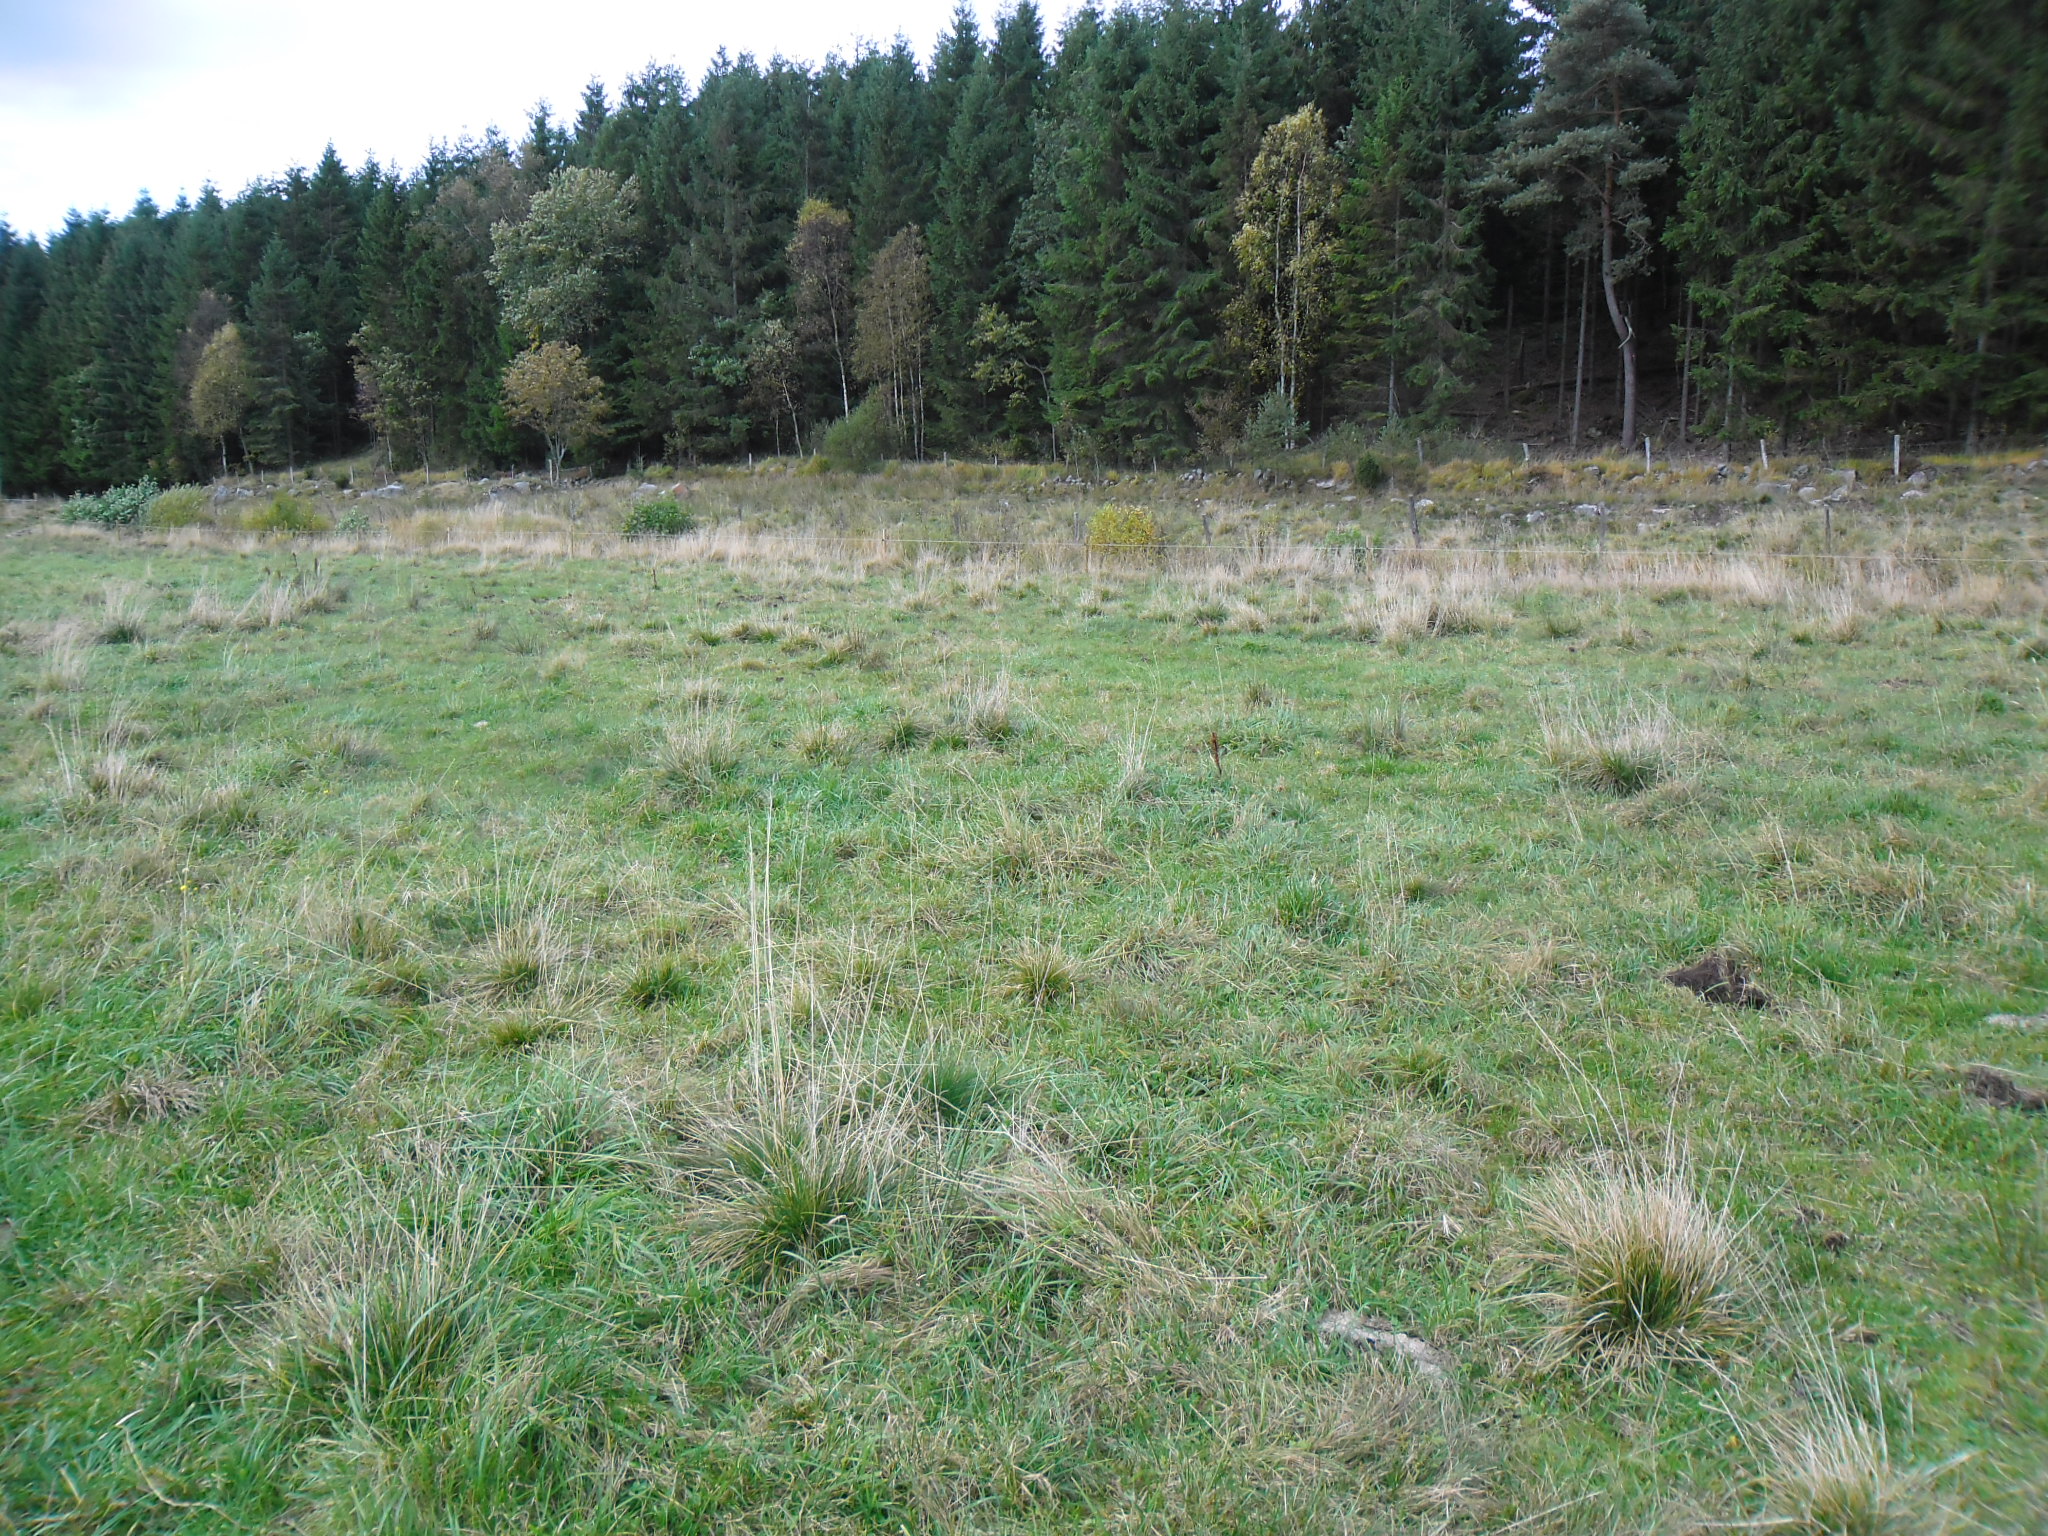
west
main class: Grassland
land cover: Grassland without tree/shrub cover
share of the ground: > 75 %
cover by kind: herbaceous plants 100 %
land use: Agriculture (excluding fallow land and kitchen gardens)
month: October
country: SE
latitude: 56.7061
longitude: 13.1819
